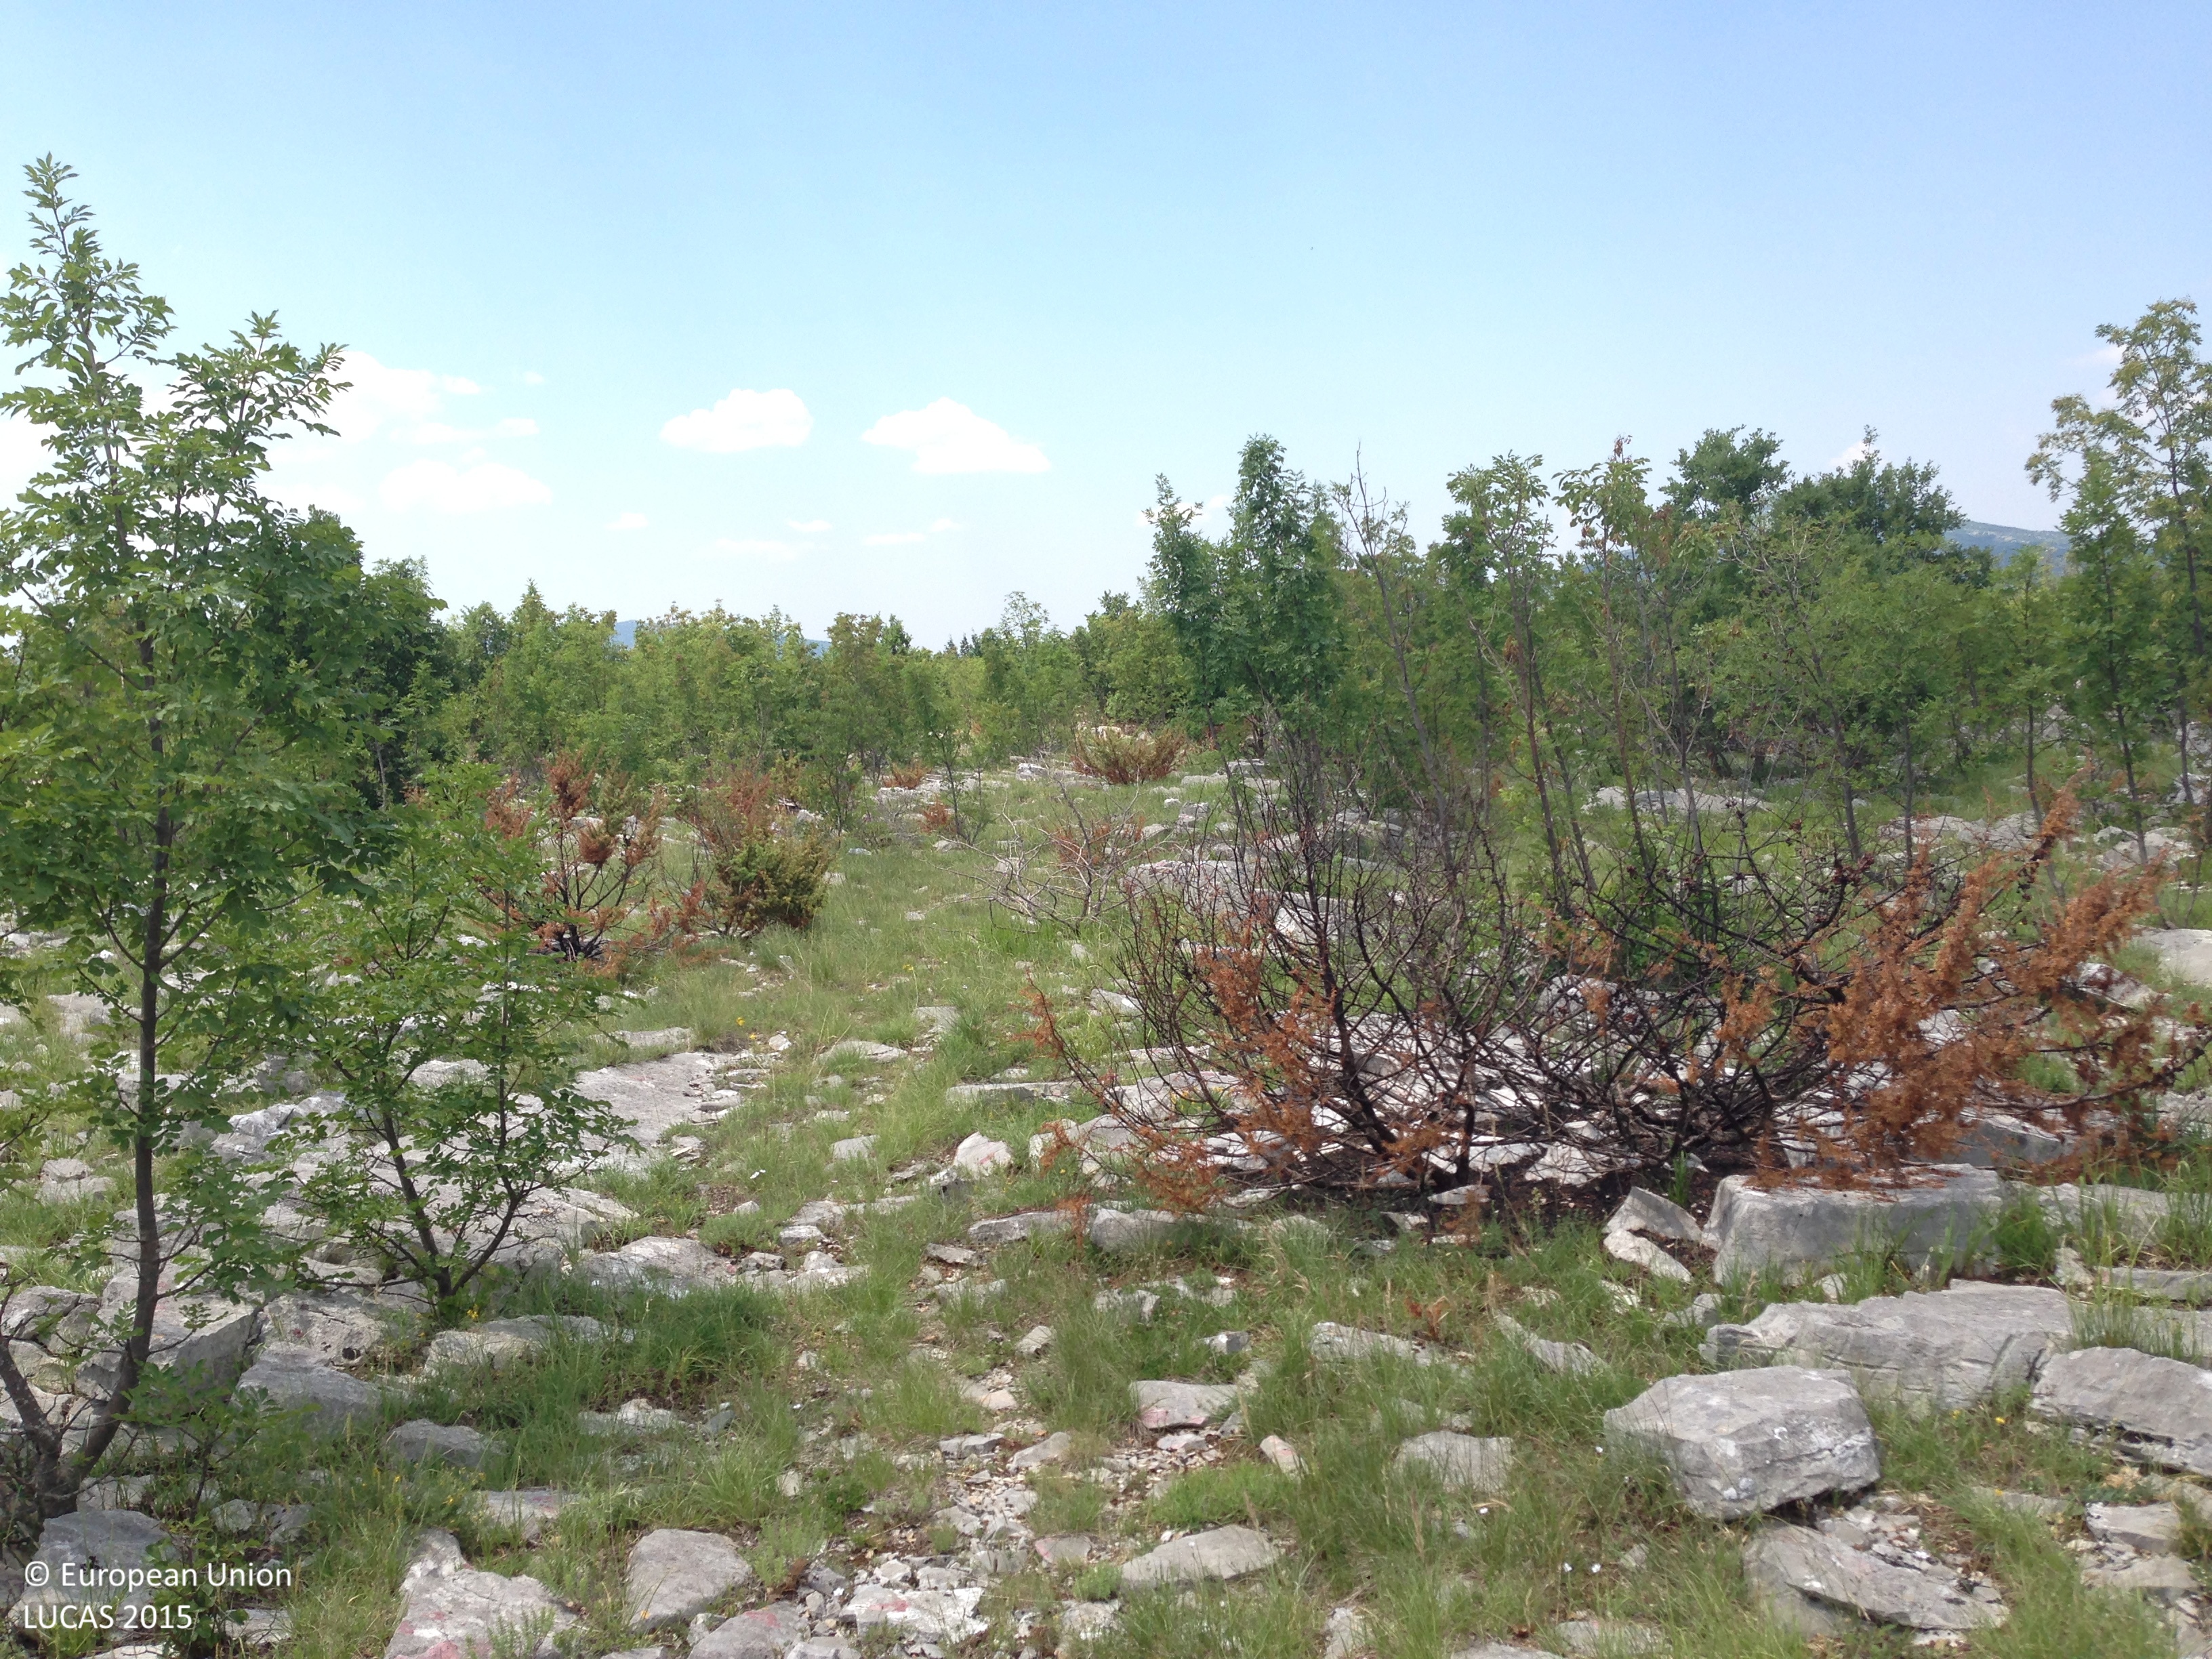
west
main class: Woodland
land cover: Broadleaved woodland
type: thermophilous deciduous forest
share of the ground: 25 - 50 %
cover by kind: broadleaved forest trees 45 %, unconsolidated bare surface 30 %, herbaceous plants 15 %, shrubs 10 %
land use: Semi-natural and natural areas not in use
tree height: < 5 m
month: June
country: HR
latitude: 43.7526
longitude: 16.4374
